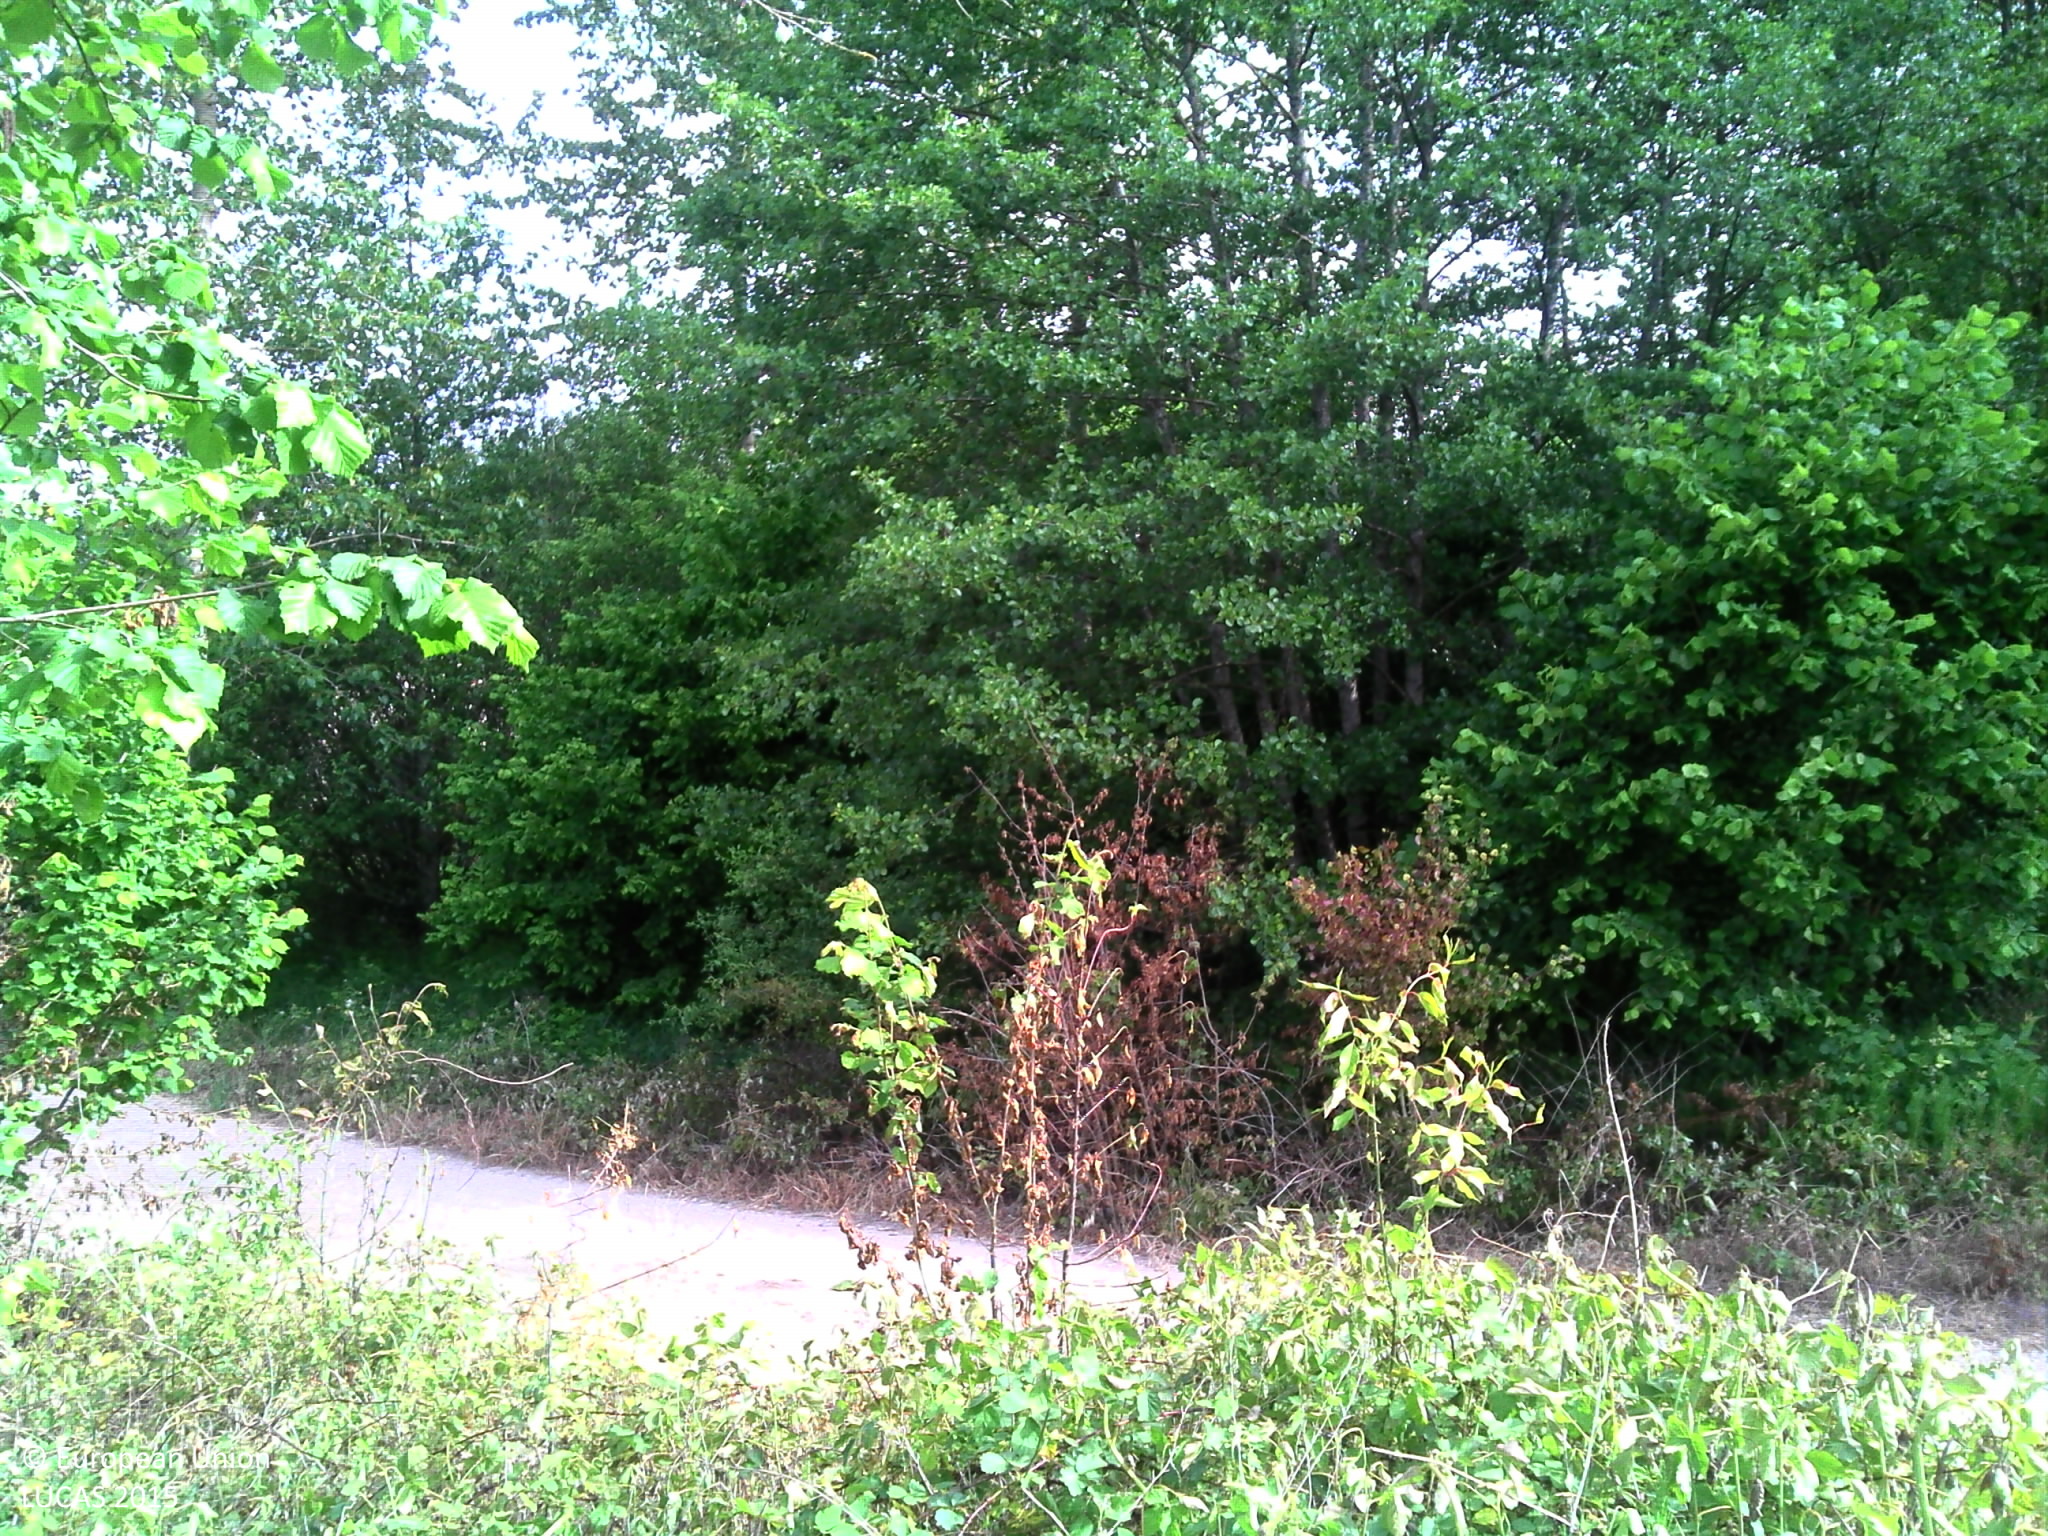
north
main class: Grassland
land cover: Spontaneously vegetated surfaces
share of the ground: > 75 %
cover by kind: herbaceous plants 95 %, shrubs 5 %
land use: Semi-natural and natural areas not in use
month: May
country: FR
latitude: 47.9168
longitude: 5.9997
